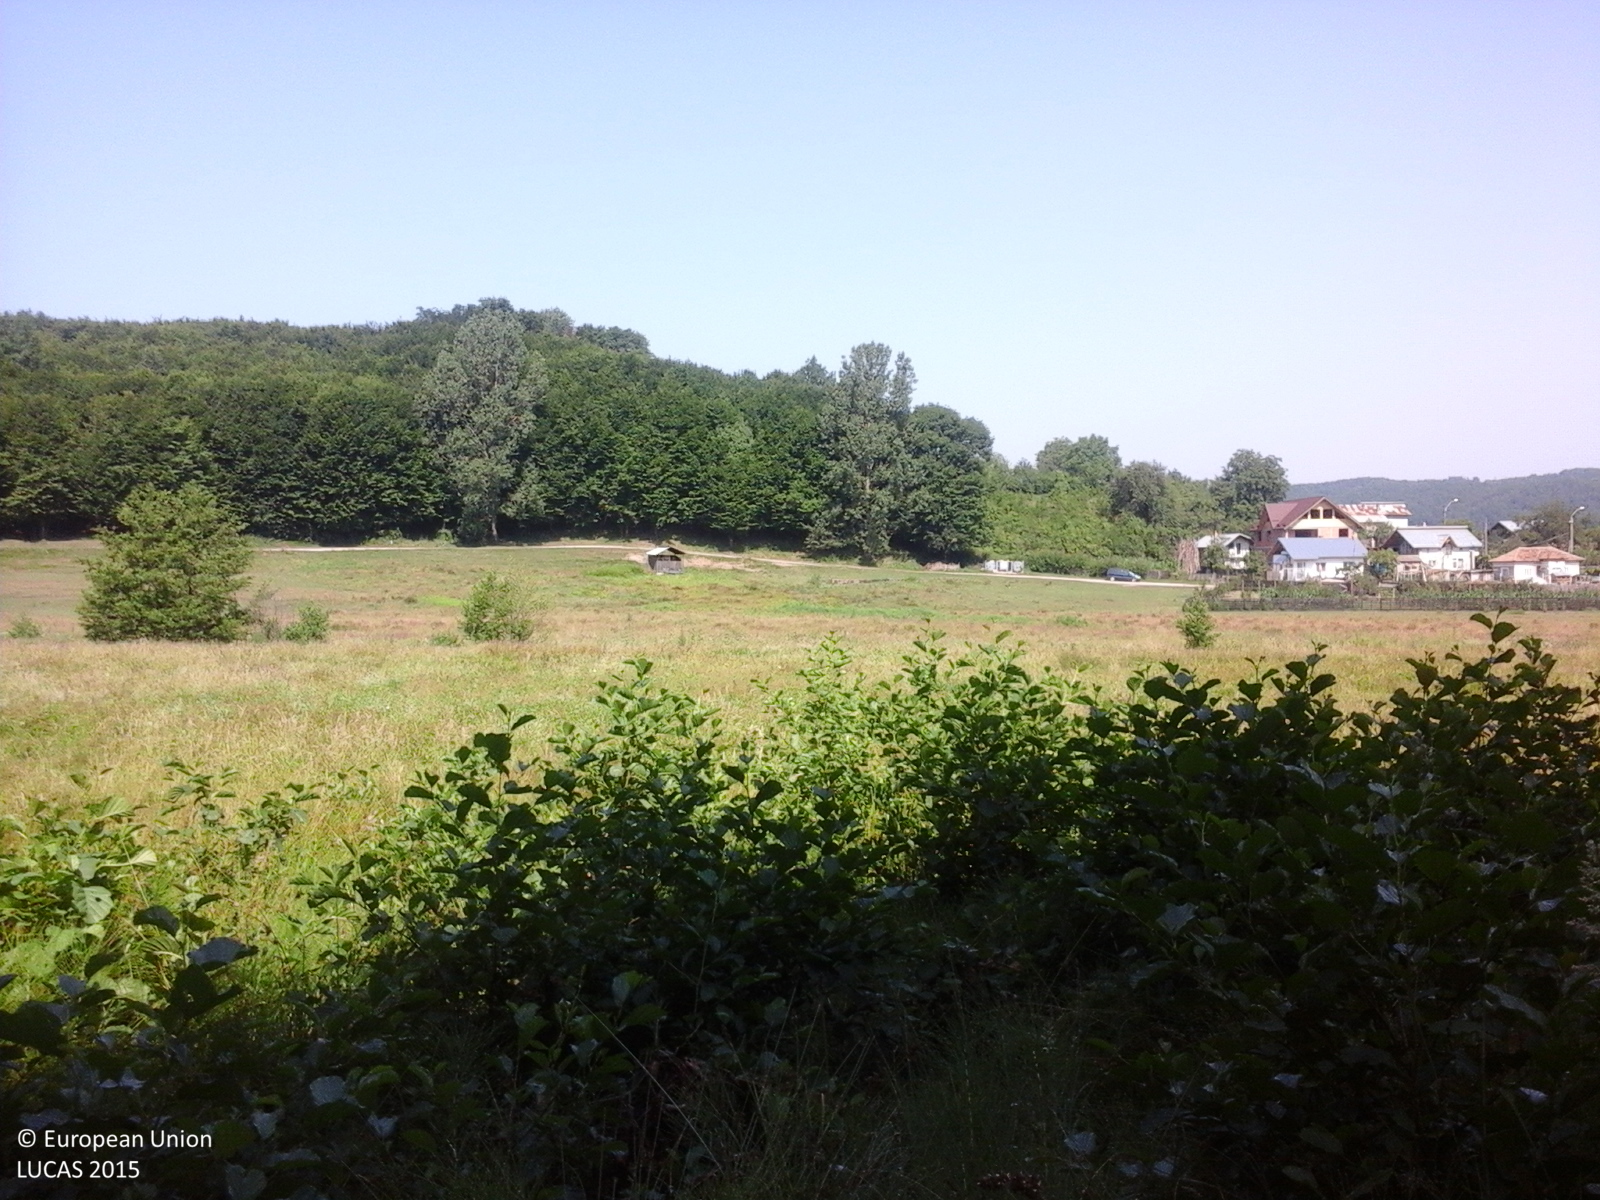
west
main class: Grassland
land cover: Grassland with sparse tree/shrub cover
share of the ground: > 75 %
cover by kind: herbaceous plants 90 %, broadleaved forest trees 5 %, shrubs 5 %
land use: Forestry
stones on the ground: 10 - 25 %
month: July
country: RO
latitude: 44.8786
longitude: 24.7772
